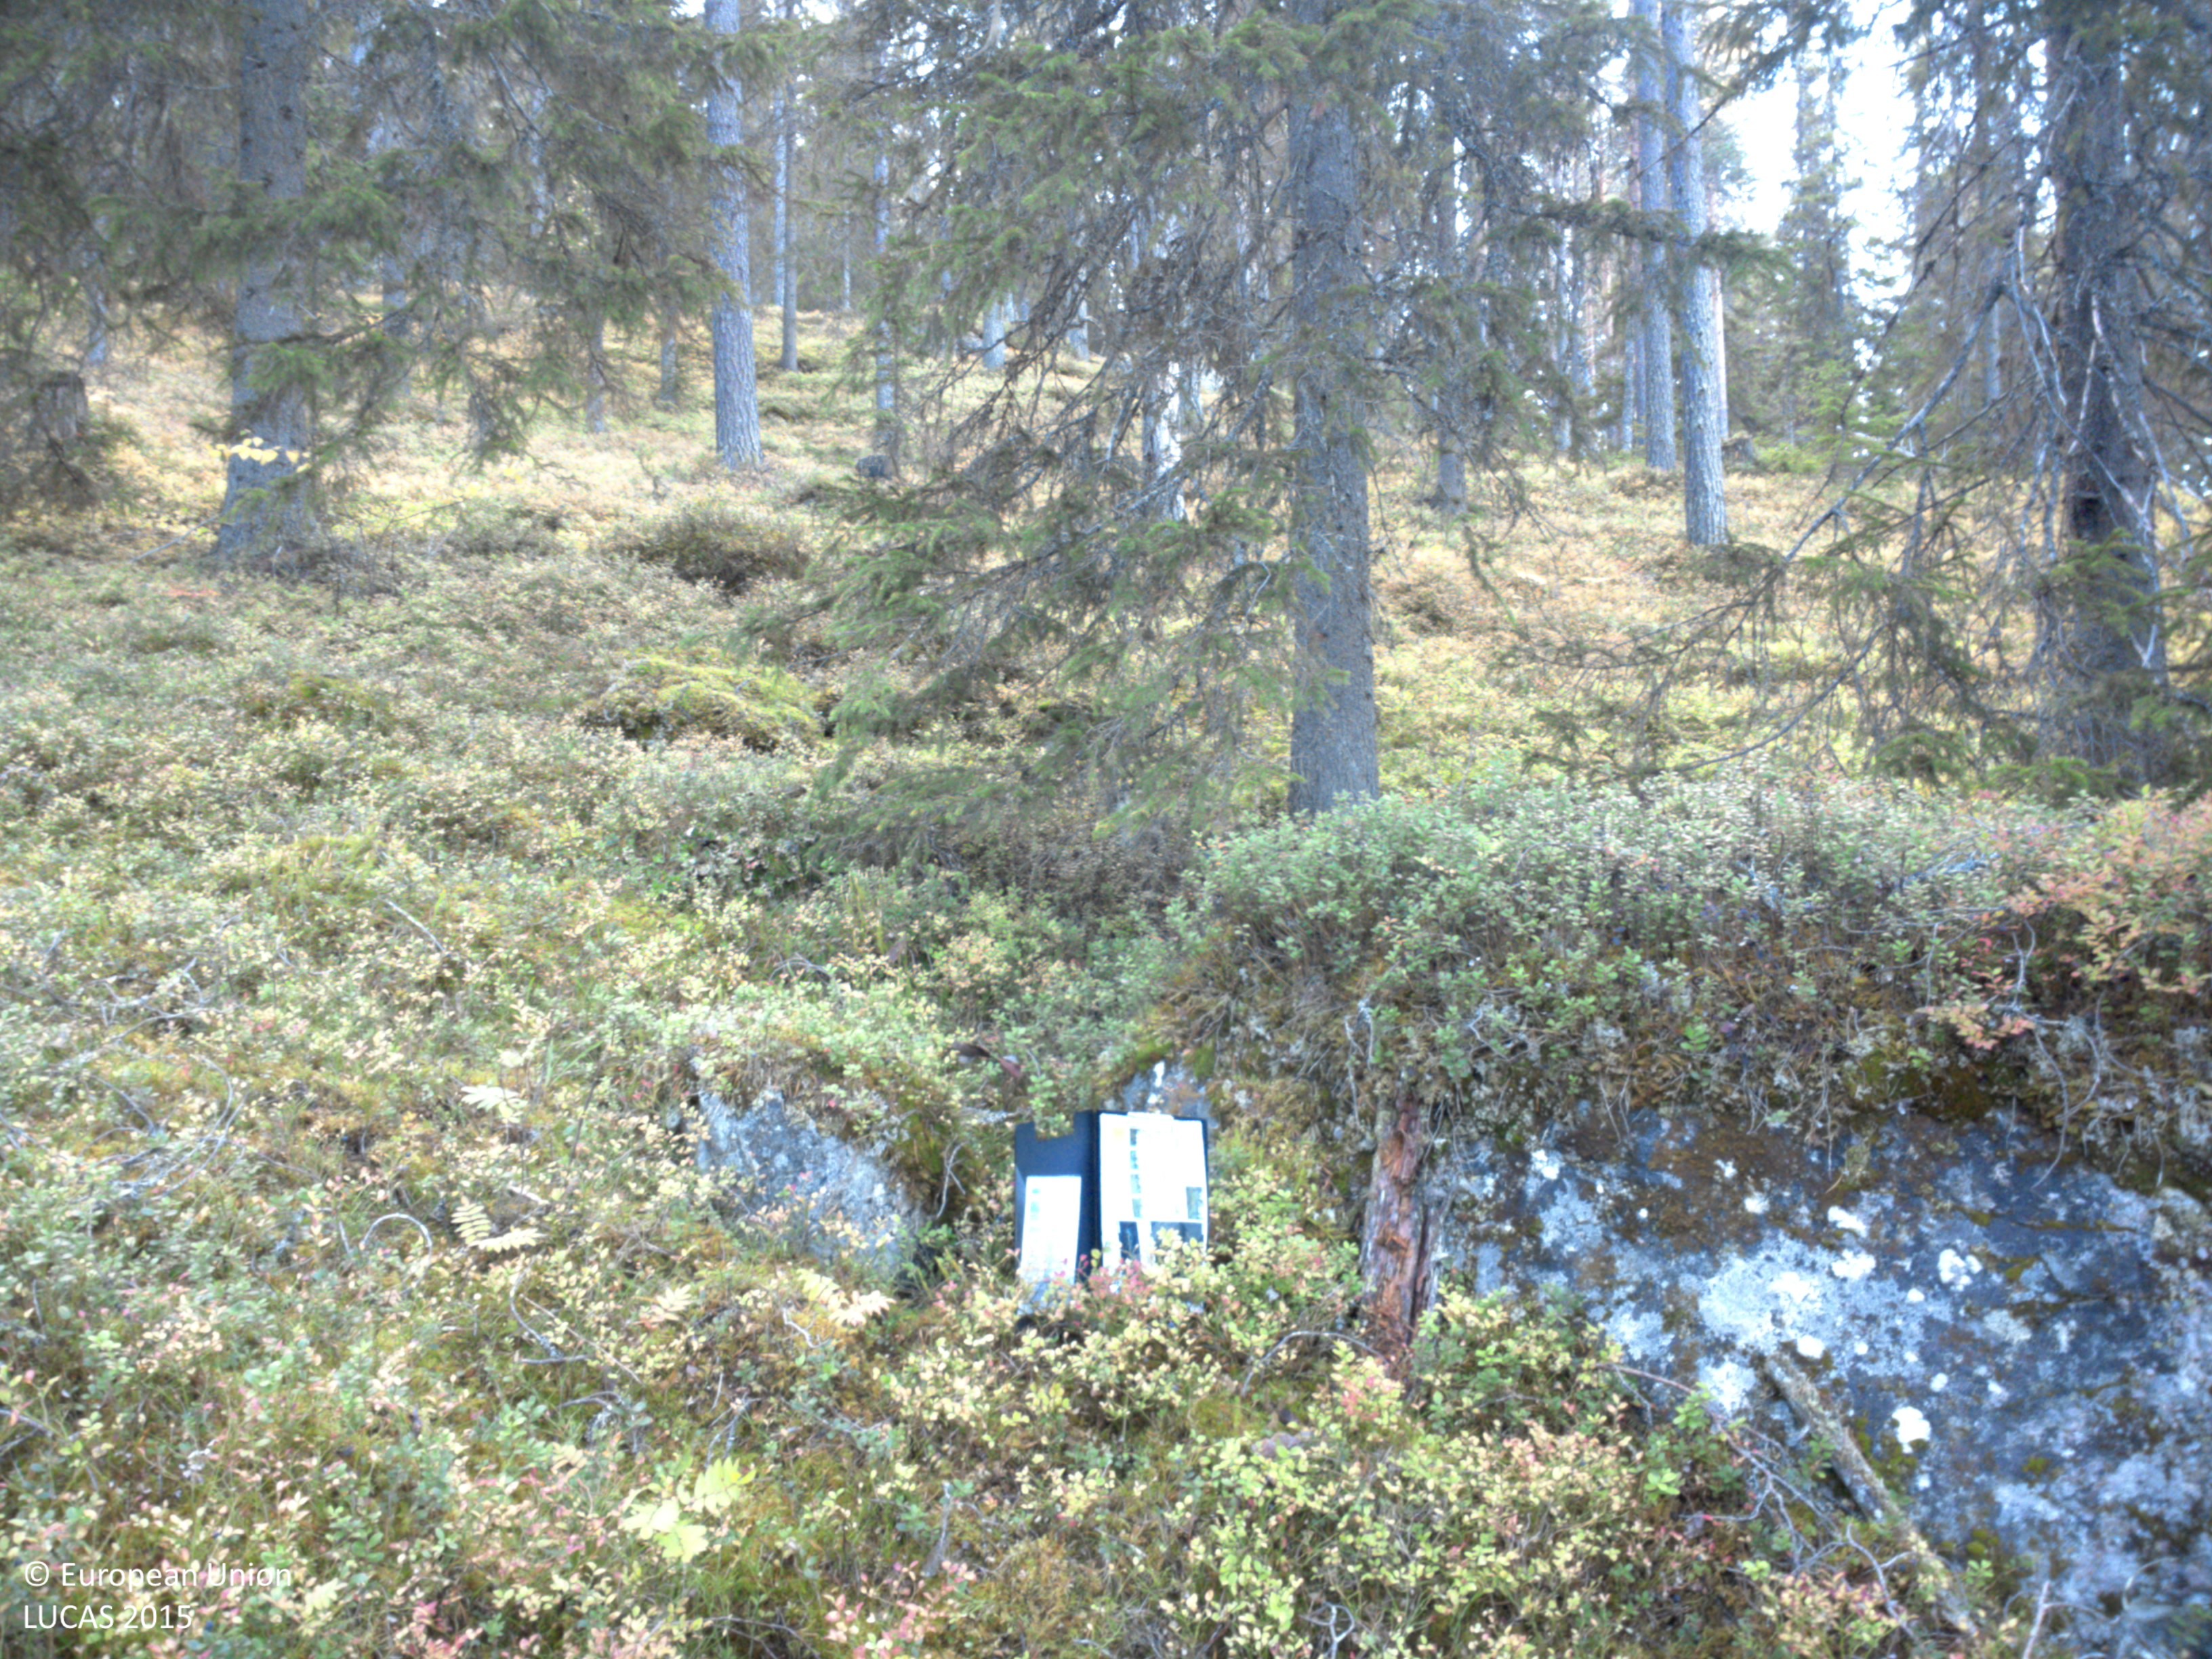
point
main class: Woodland
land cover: Other coniferous woodland
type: boreal forest
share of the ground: 50 - 75 %
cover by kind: coniferous forest trees 70 %, shrubs 20 %, lichens and mosses 10 %
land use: Forestry
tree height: > 5 m
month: September
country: SE
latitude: 64.9680
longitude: 18.5431
